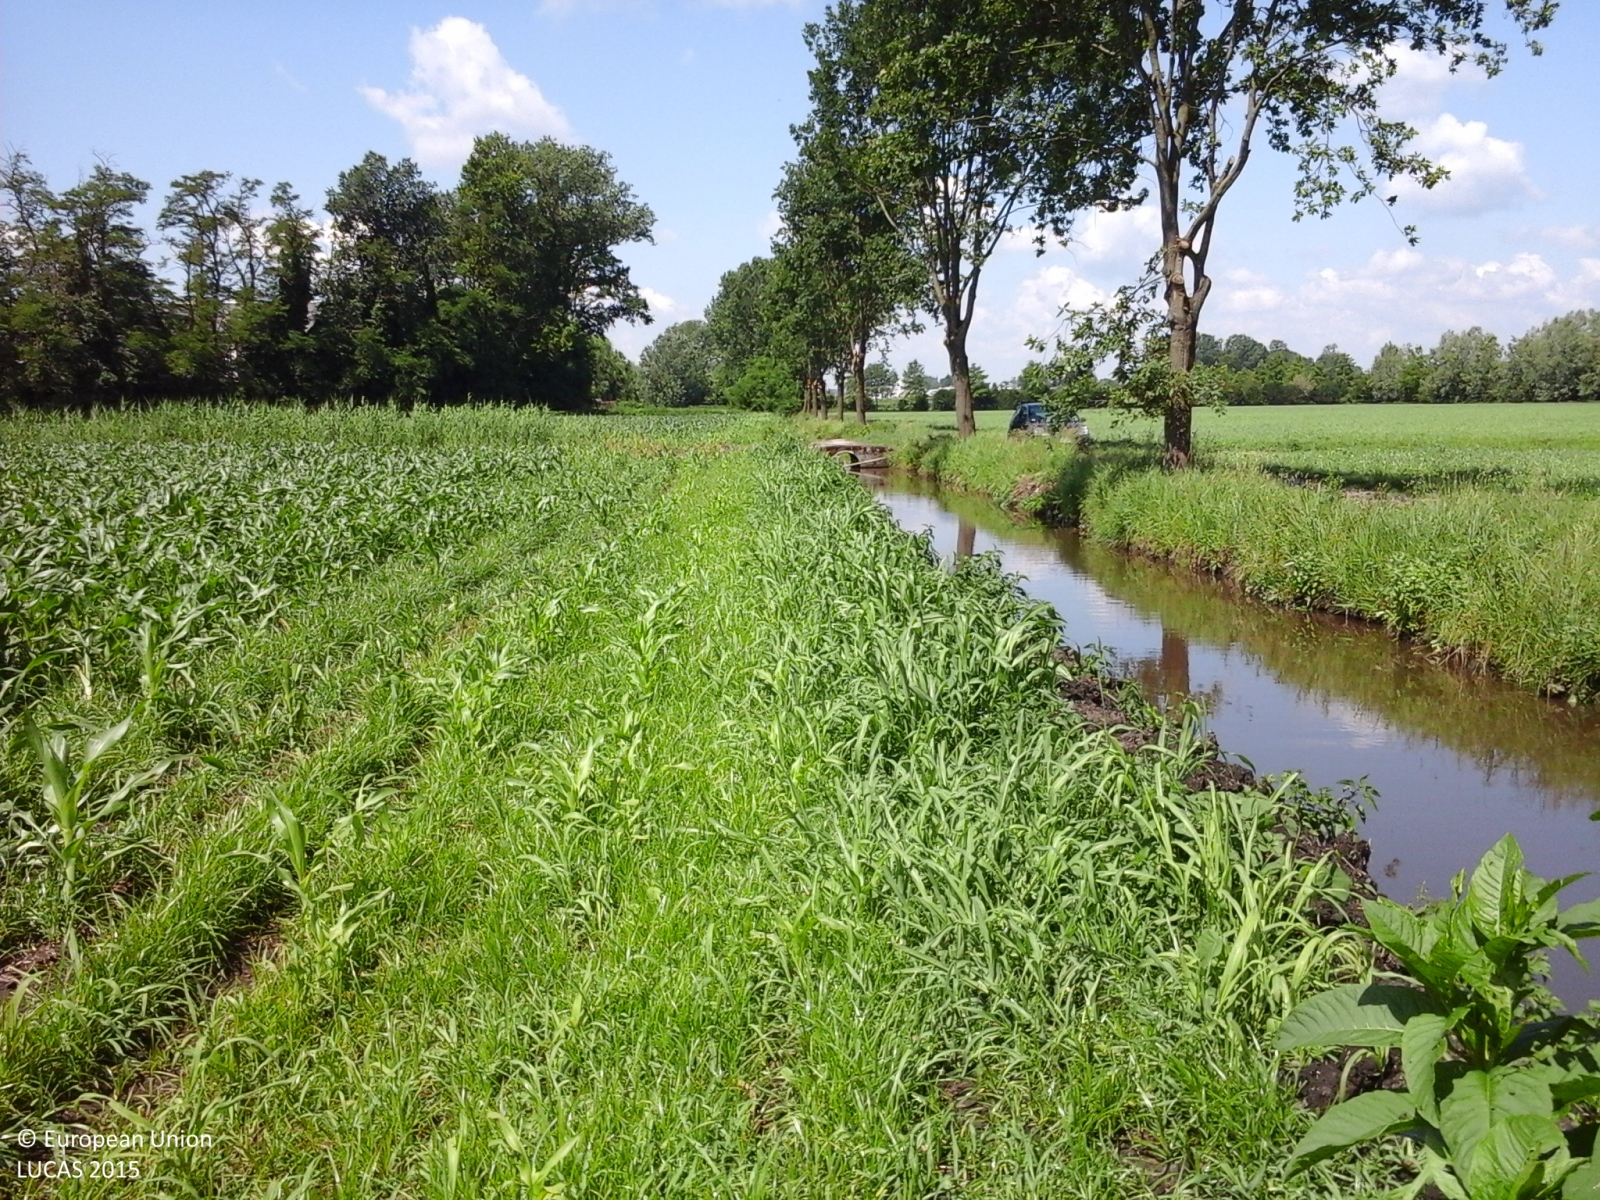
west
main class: Cropland
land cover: Maize
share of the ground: > 75 %
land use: Agriculture (excluding fallow land and kitchen gardens)
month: May
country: IT
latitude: 45.3775
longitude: 9.6048
